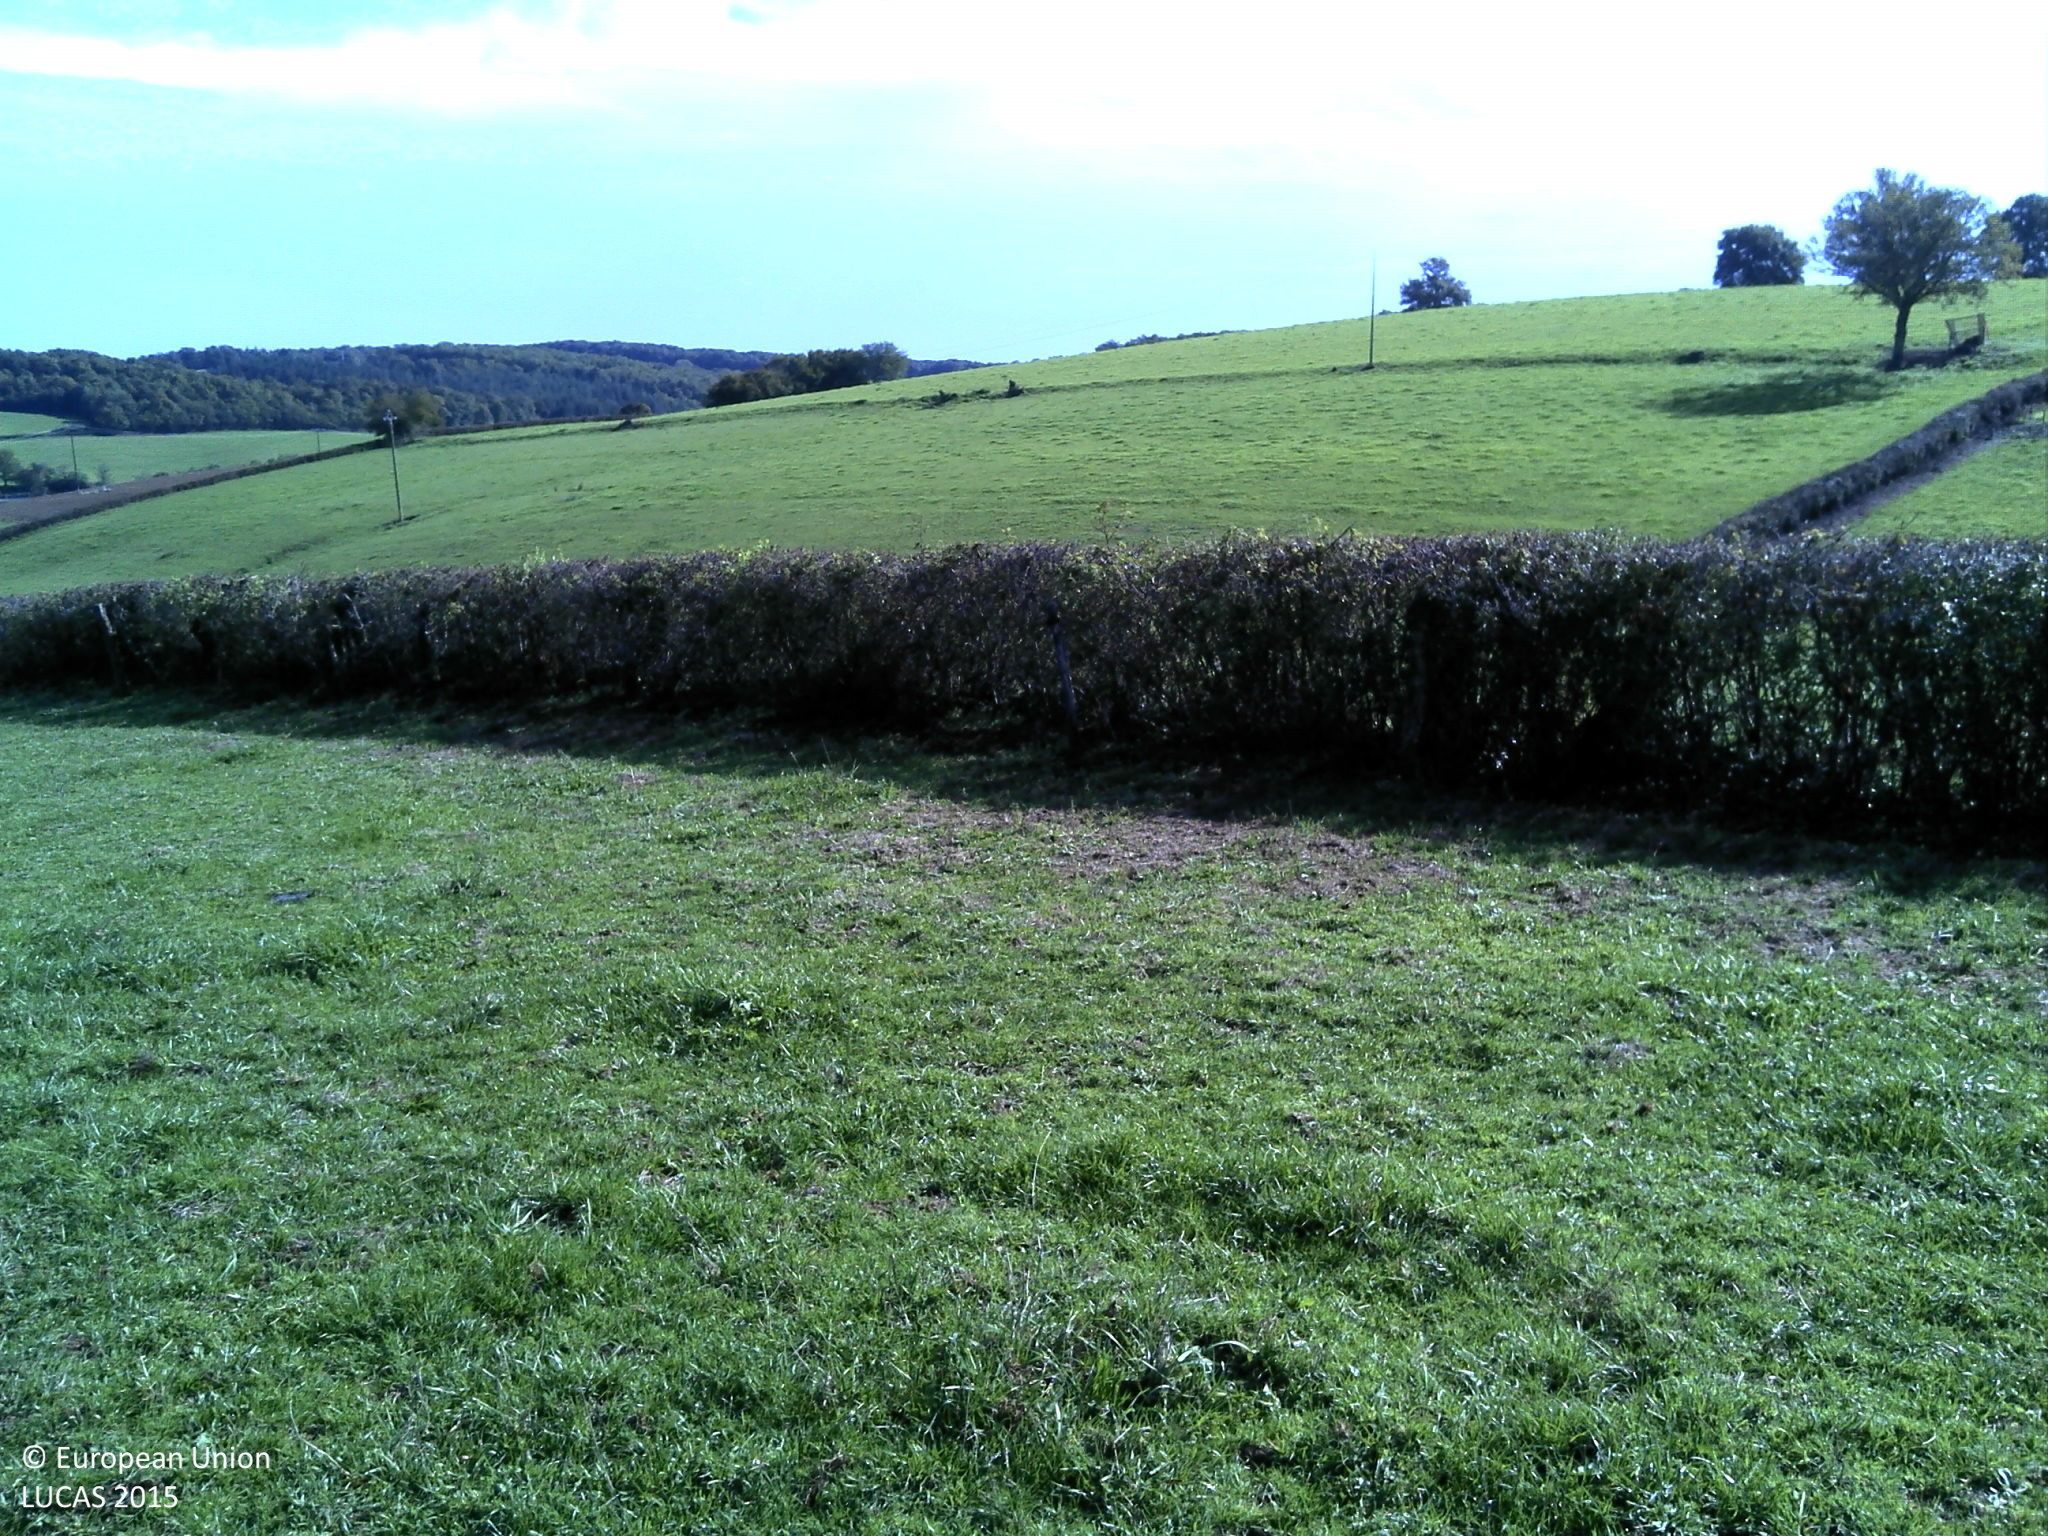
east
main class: Grassland
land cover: Grassland without tree/shrub cover
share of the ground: > 75 %
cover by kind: herbaceous plants 100 %
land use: Agriculture (excluding fallow land and kitchen gardens)
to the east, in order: Grassland without tree/shrub cover; Fences; Managed hedges; Grassland without tree/shrub cover; Fences; Managed hedges; Fences; Grassland without tree/shrub cover; Electric lines; Grassland without tree/shrub cover
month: October
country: FR
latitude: 46.6553
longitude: 4.0543
